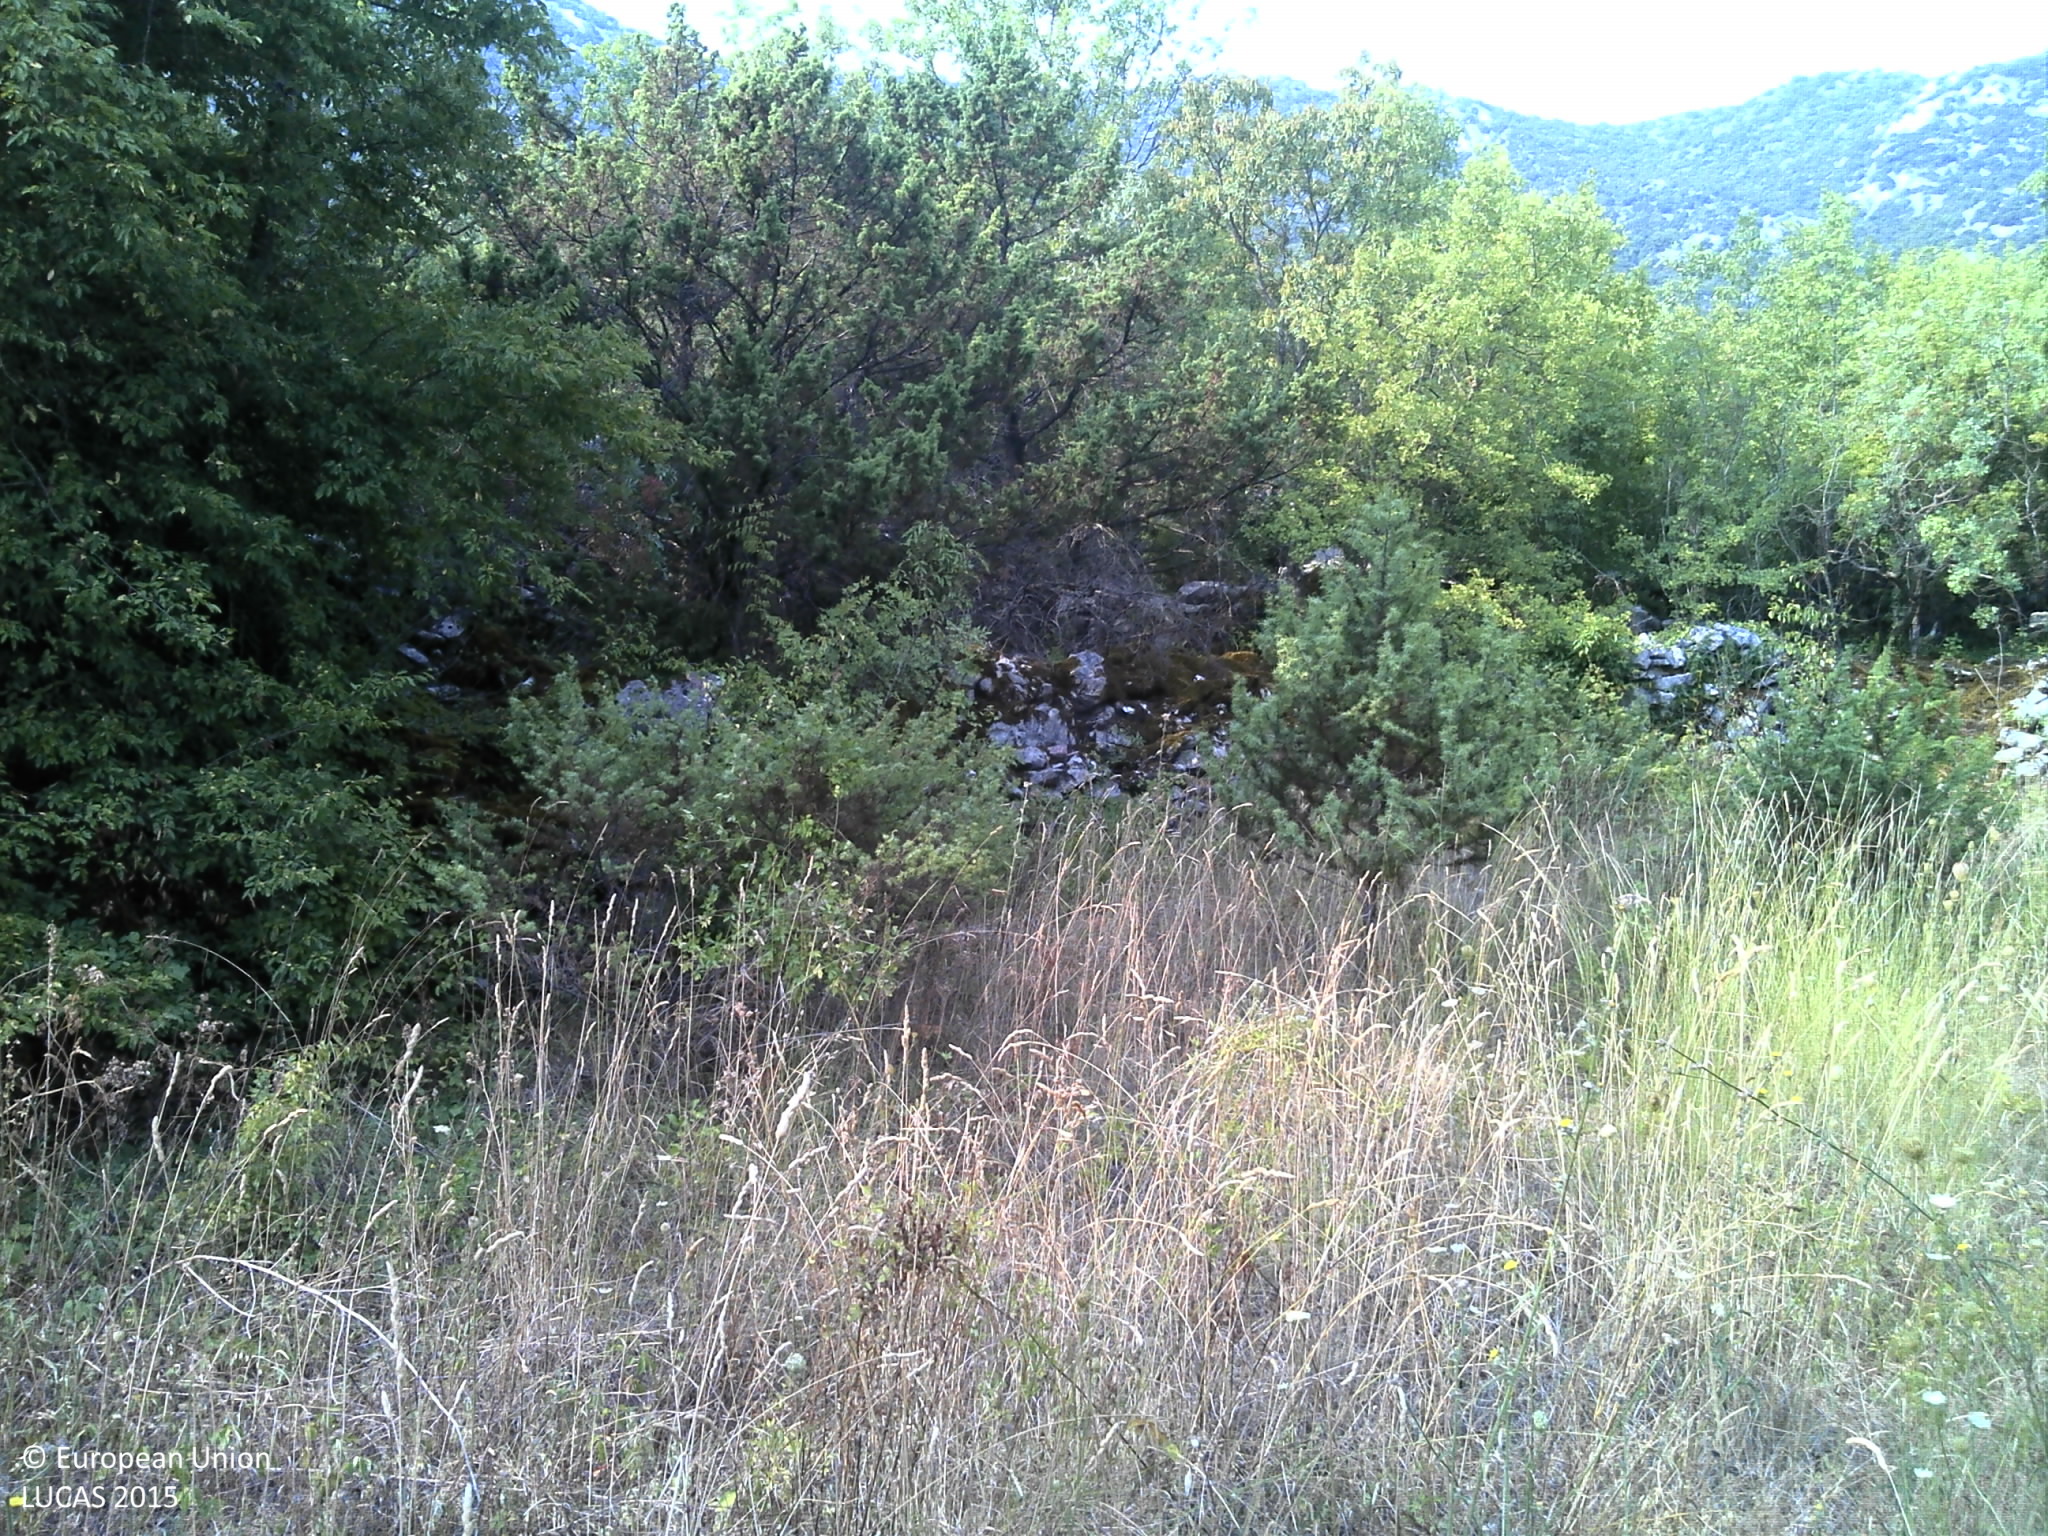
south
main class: Grassland
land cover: Grassland with sparse tree/shrub cover
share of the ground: > 75 %
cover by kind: herbaceous plants 80 %, shrubs 10 %, broadleaved forest trees 5 %, consolidated bare surface 5 %
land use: Abandoned areas
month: August
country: HR
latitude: 43.2281
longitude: 17.2430
